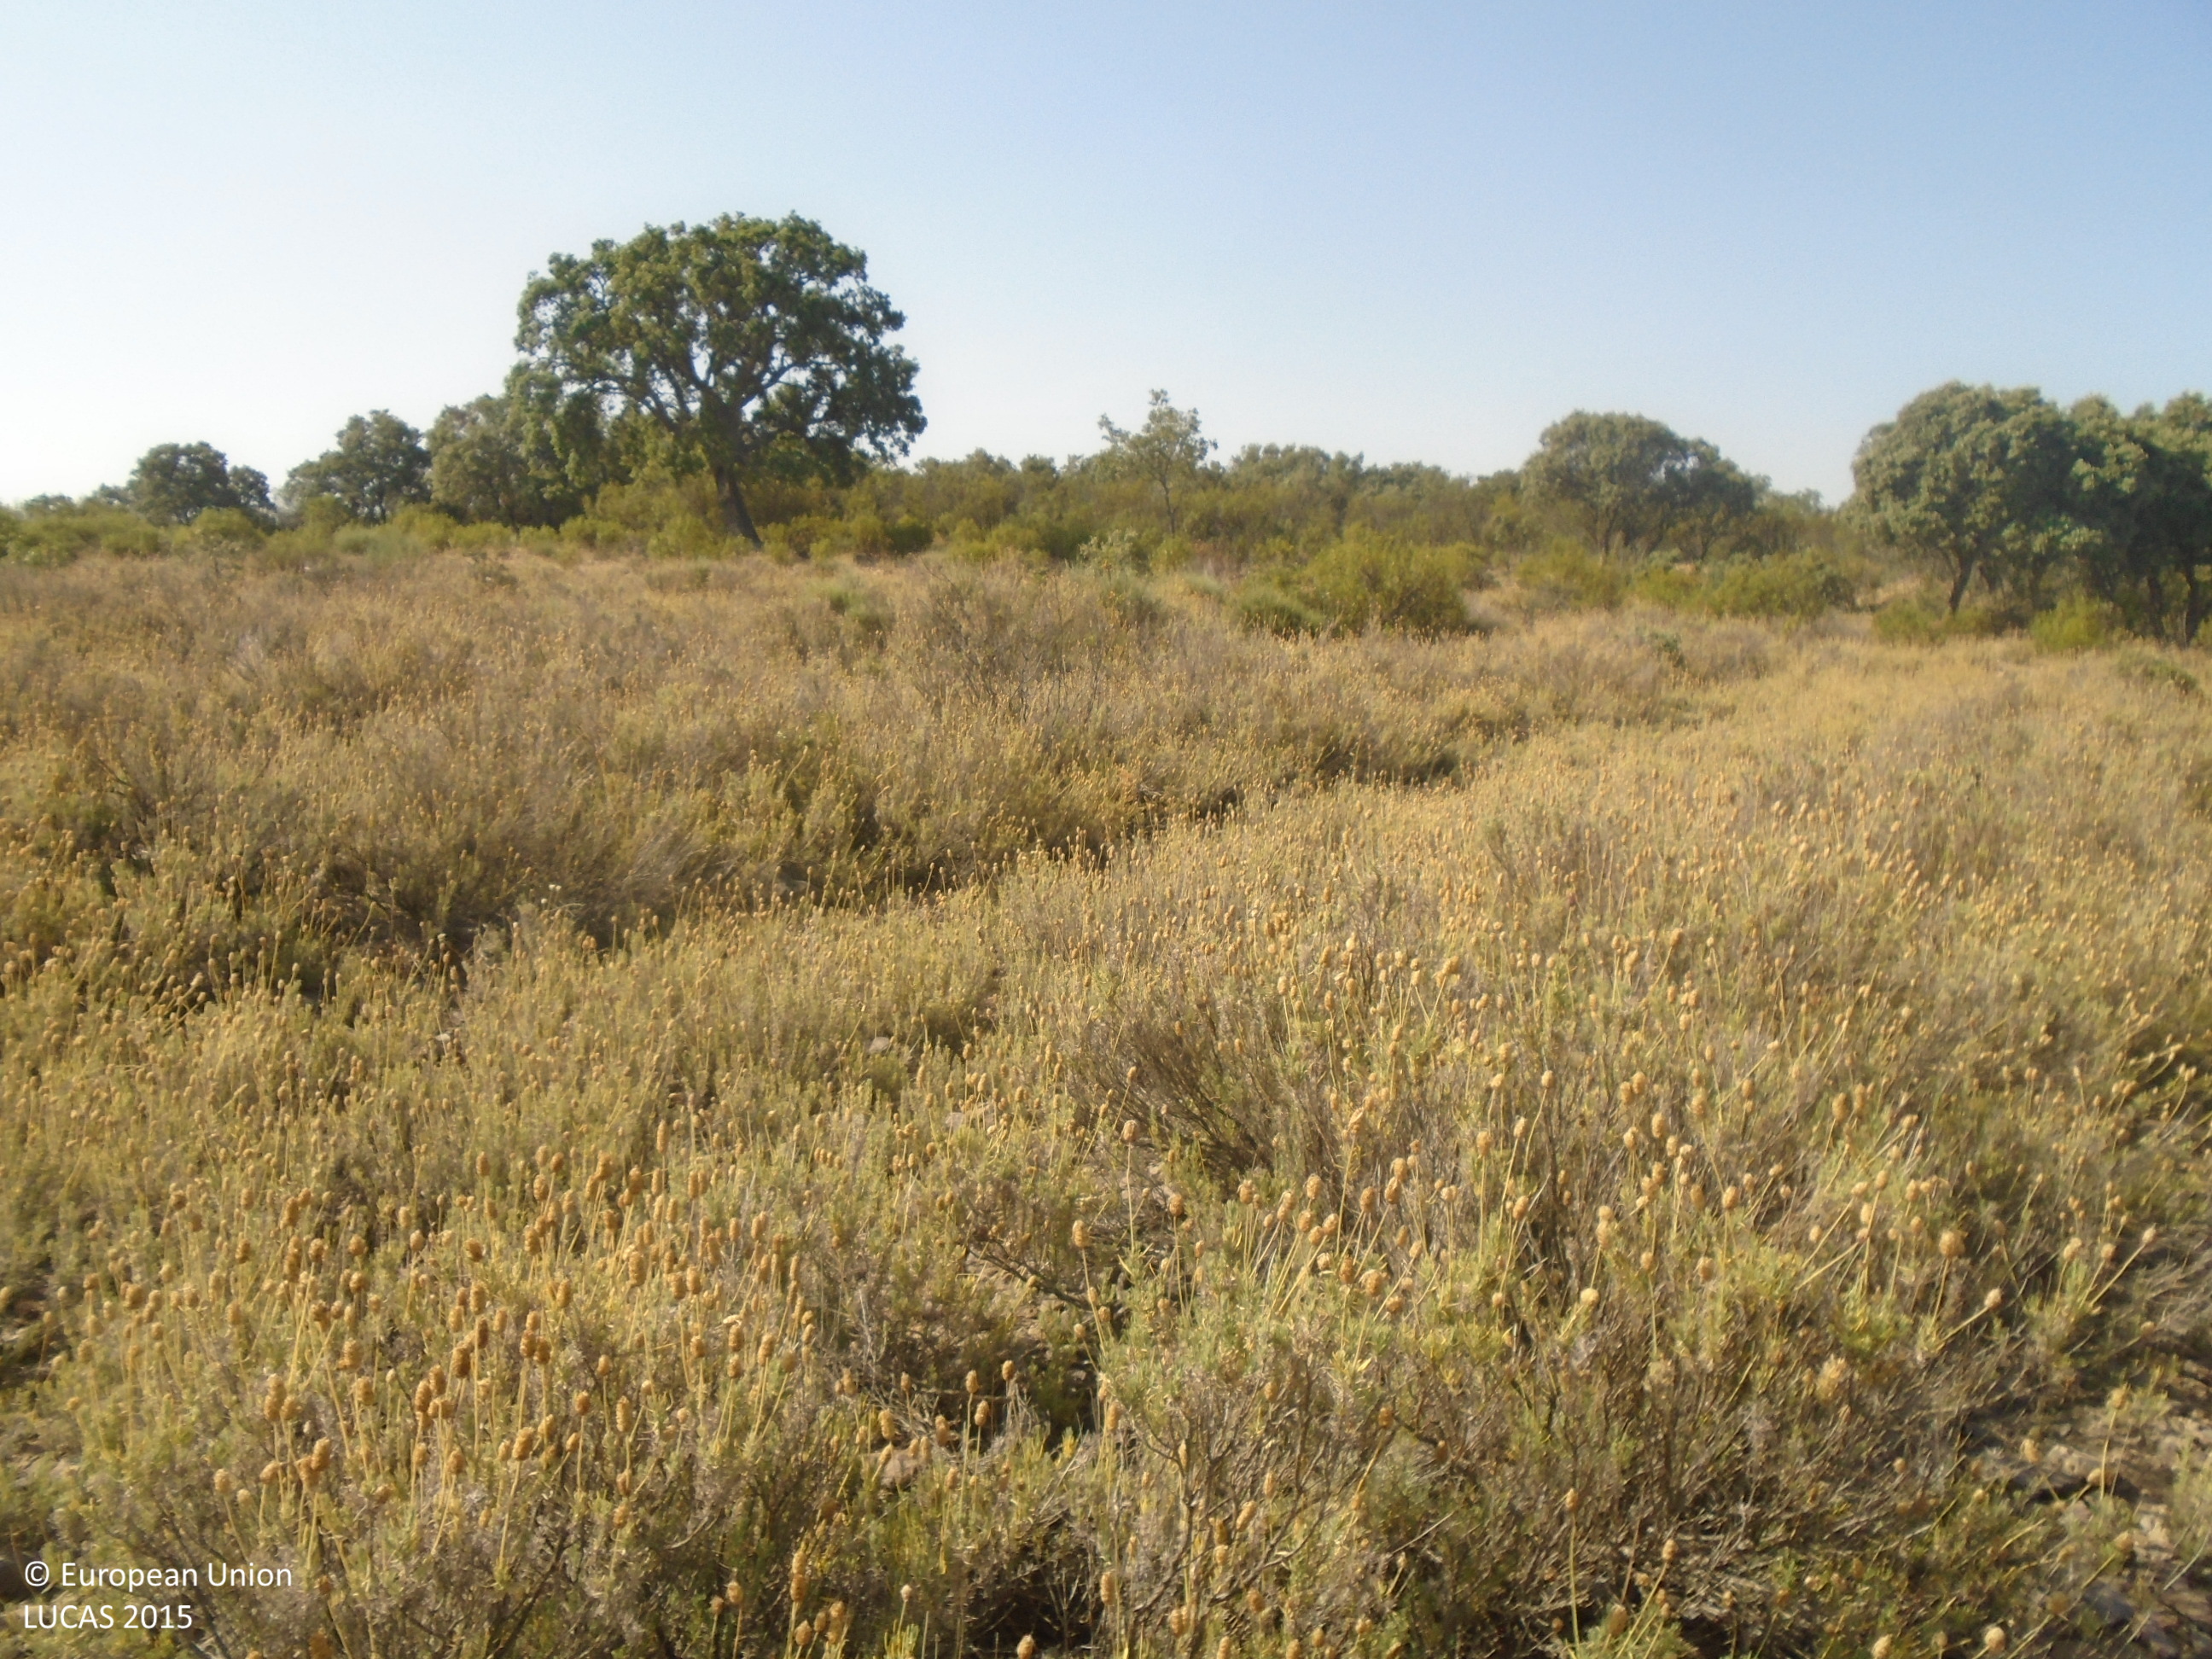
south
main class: Shrubland
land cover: Shrubland without tree cover
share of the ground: > 75 %
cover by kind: shrubs 100 %
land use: Agriculture (excluding fallow land and kitchen gardens)
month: July
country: ES
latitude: 39.2850
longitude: -4.0662
